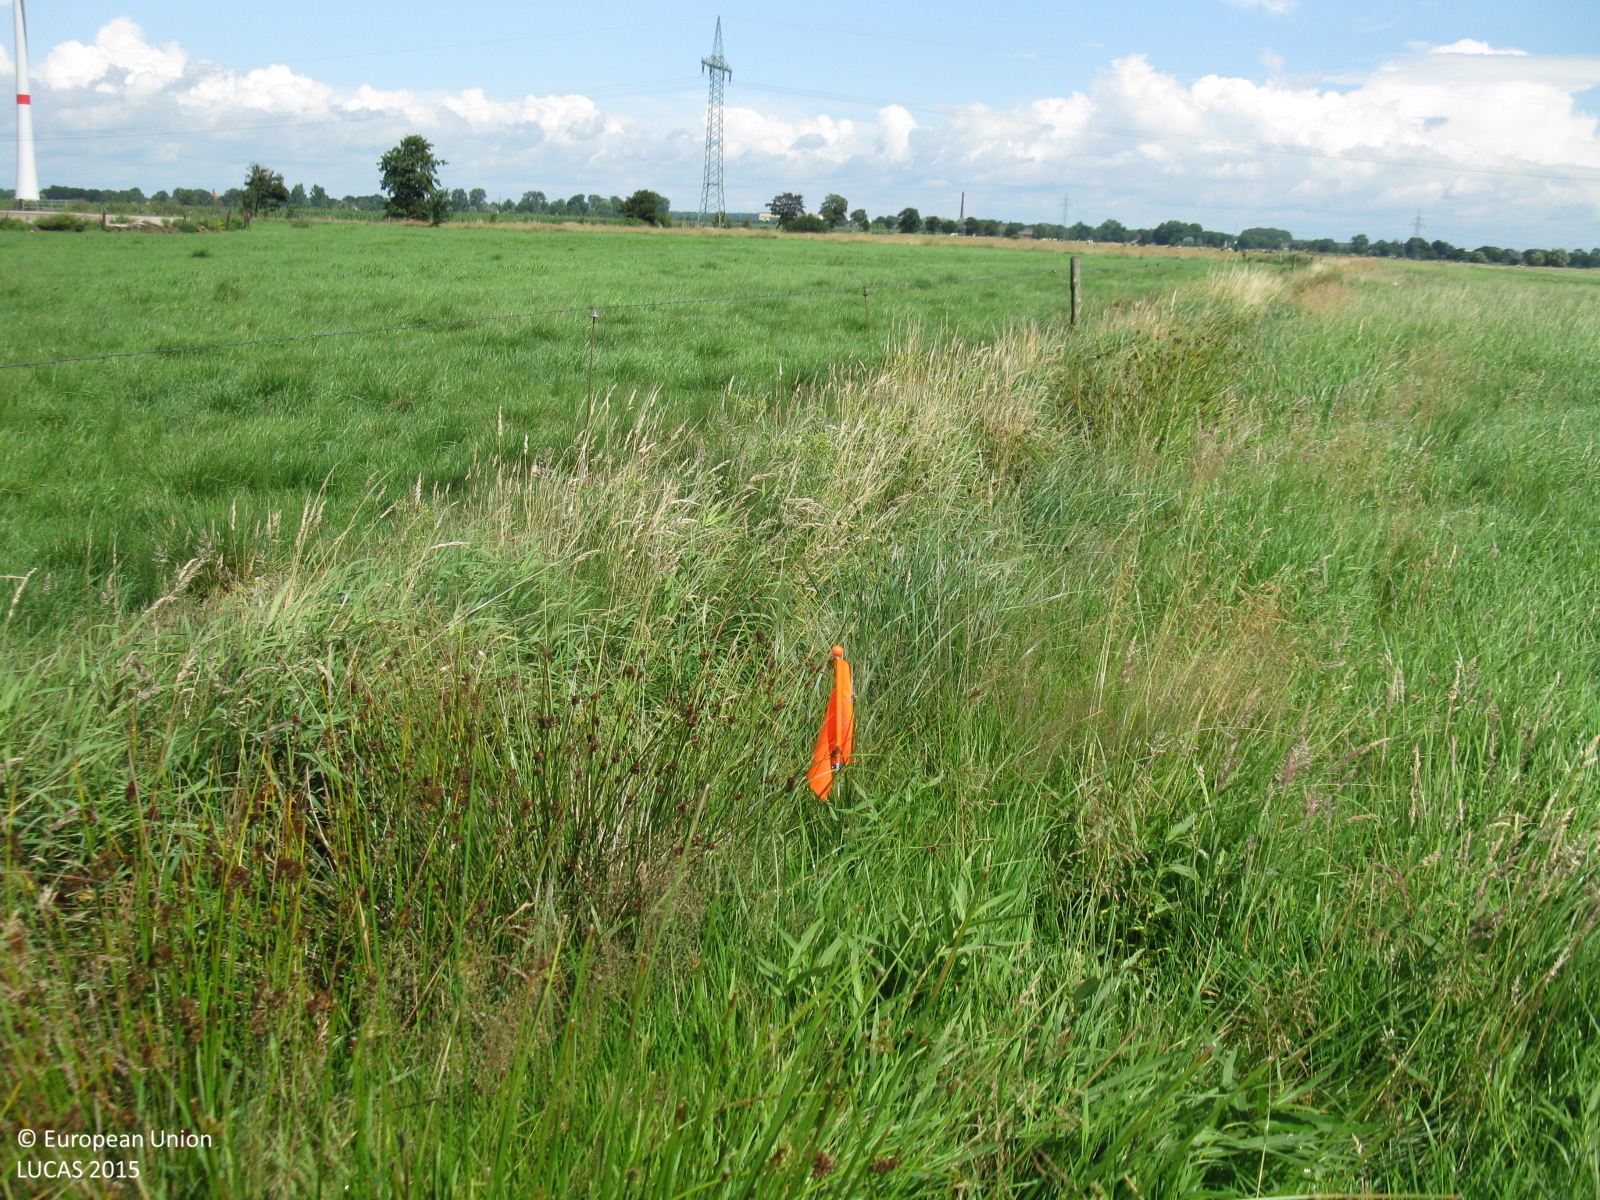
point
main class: Grassland
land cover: Grassland without tree/shrub cover
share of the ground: > 75 %
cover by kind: herbaceous plants 100 %
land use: Agriculture (excluding fallow land and kitchen gardens)
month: July
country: DE
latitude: 53.1240
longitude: 8.5809
